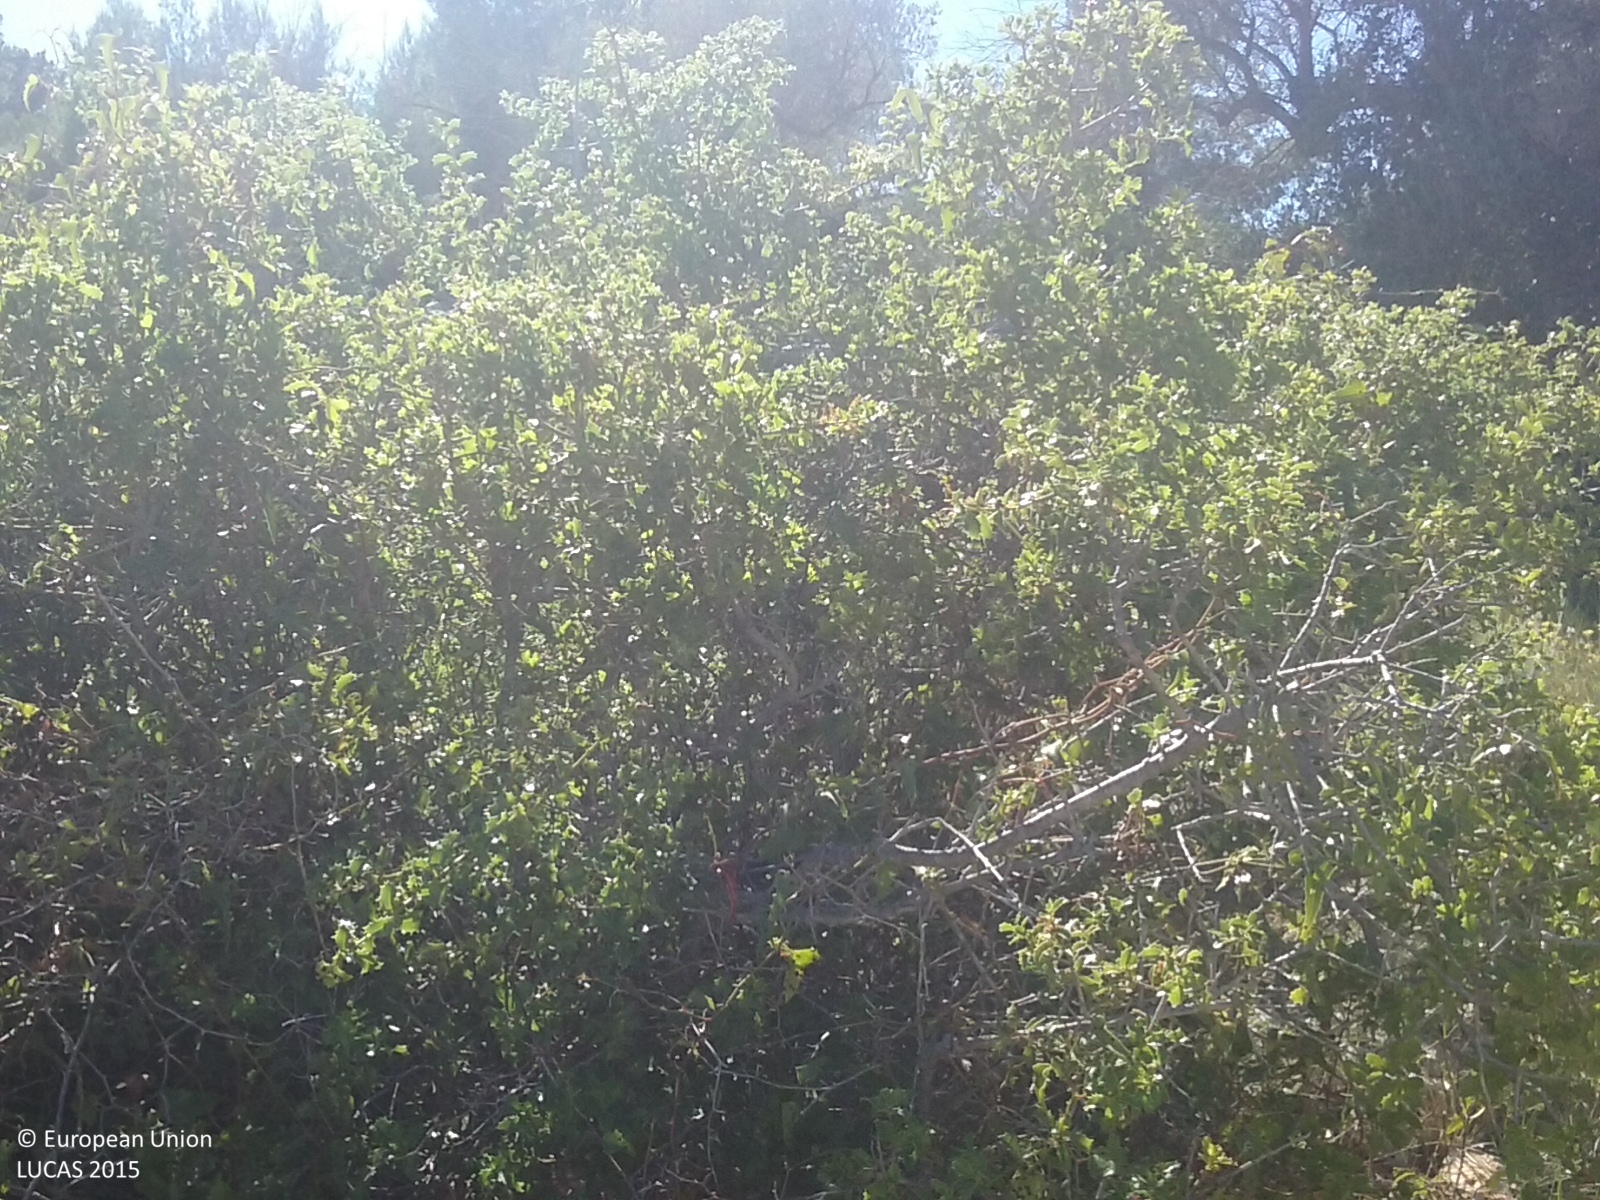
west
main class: Cropland
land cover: Olive groves
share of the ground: 25 - 50 %
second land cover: Spontaneously vegetated surfaces
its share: 10 - 25 %
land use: Agriculture (excluding fallow land and kitchen gardens)
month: May
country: ES
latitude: 40.3797
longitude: 0.2319
